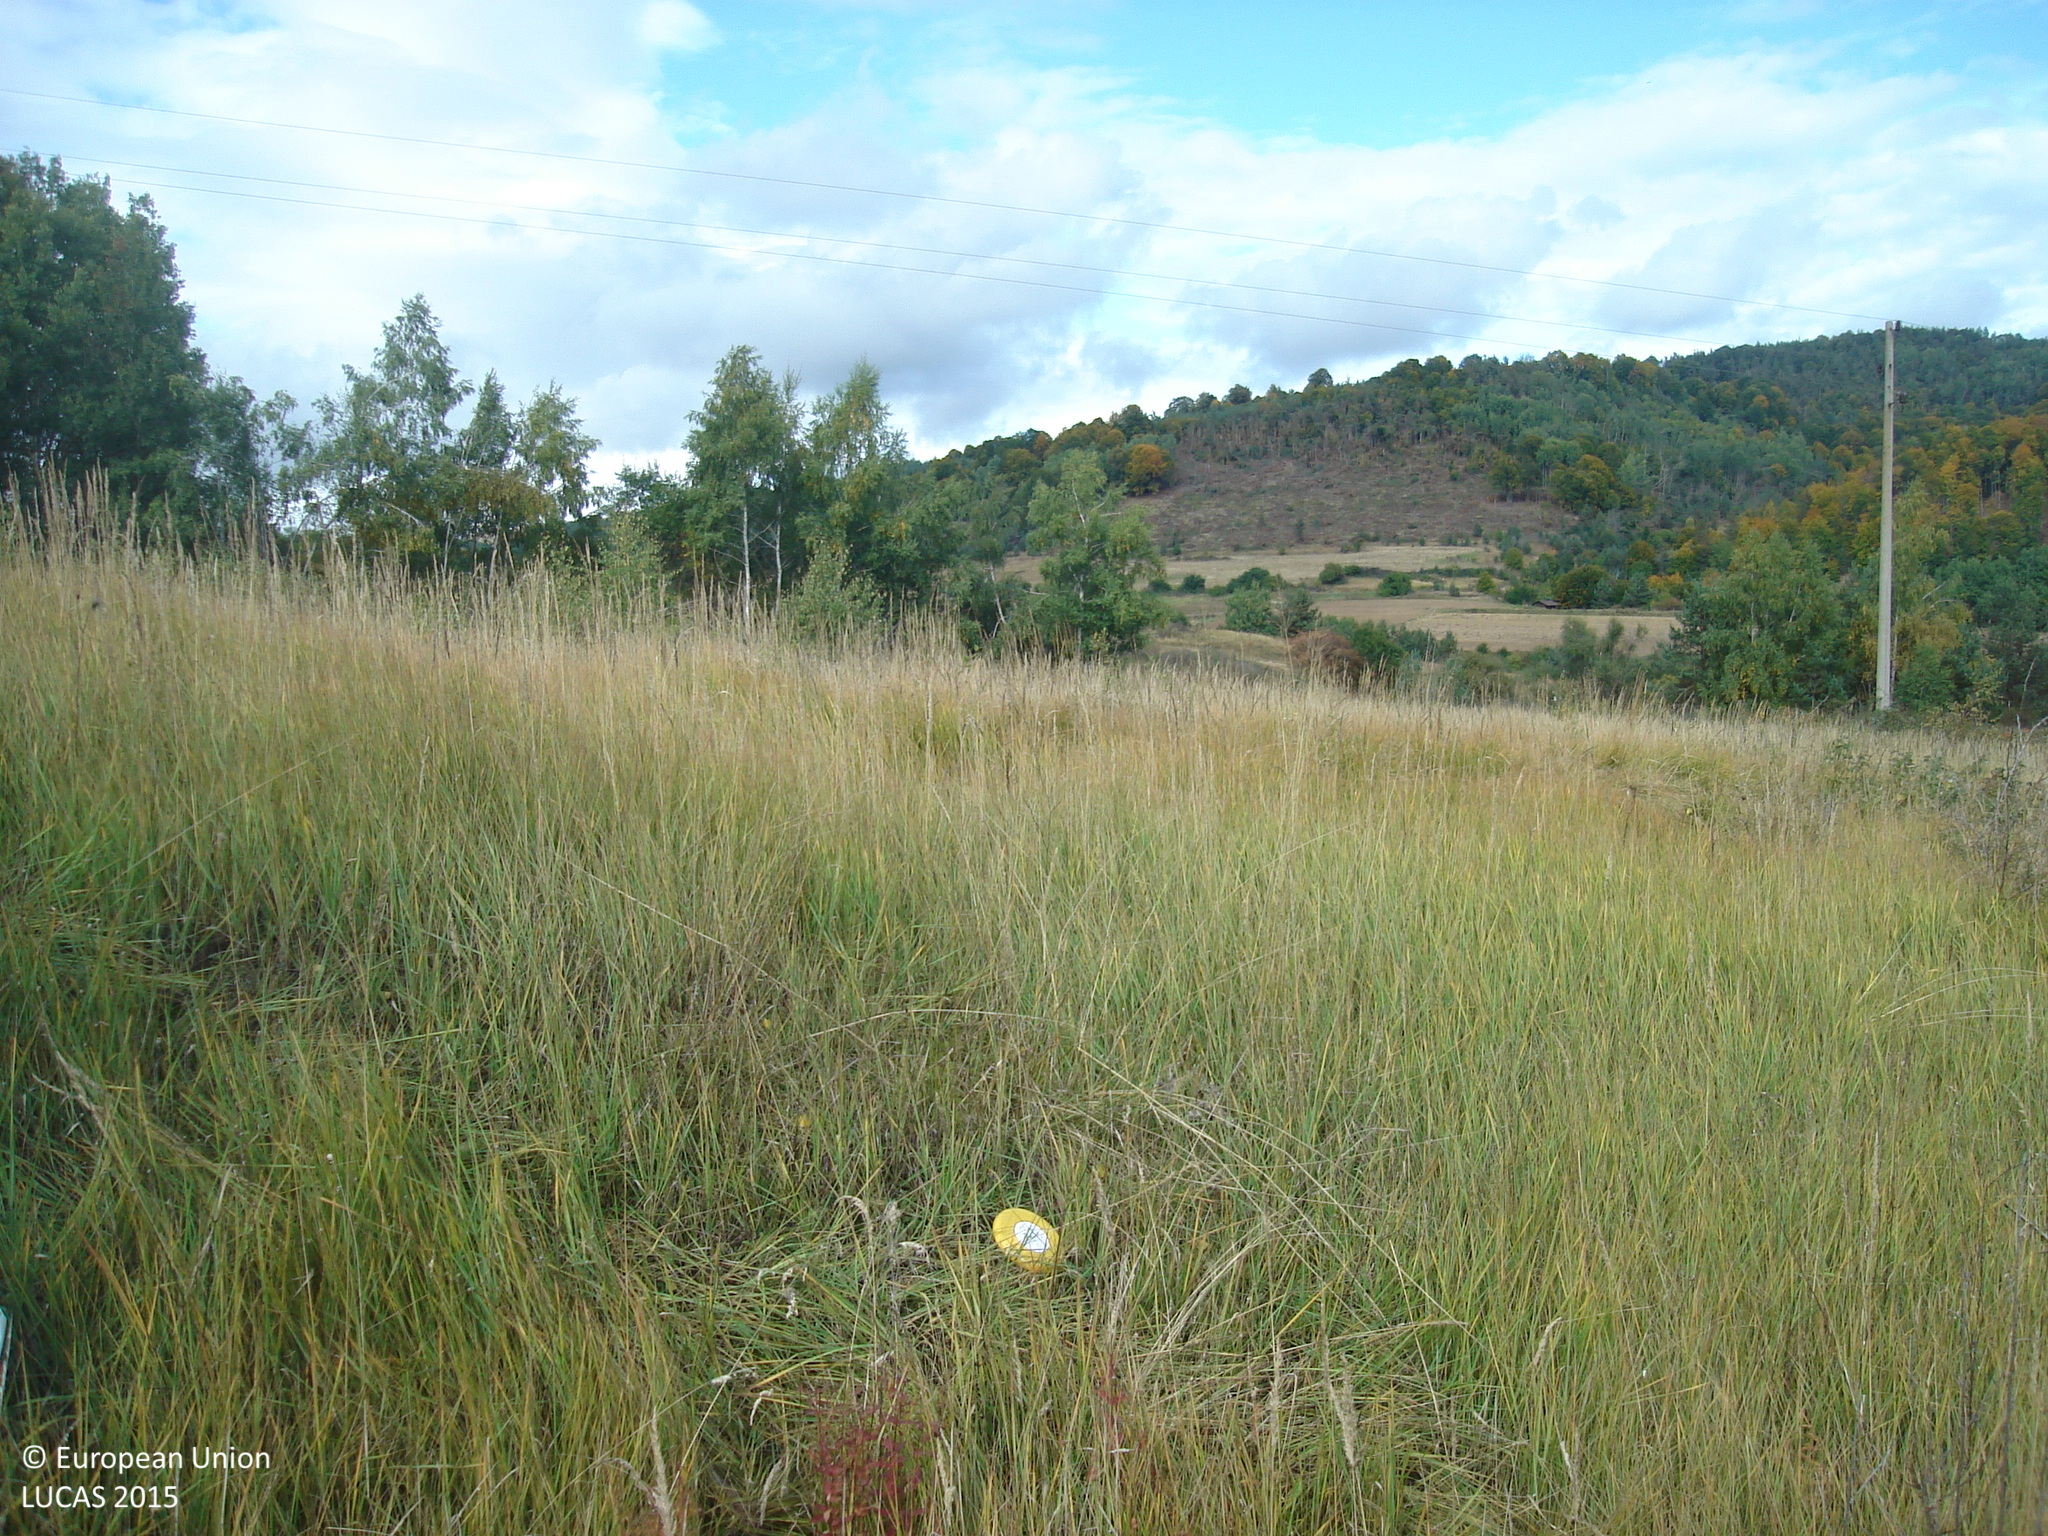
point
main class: Grassland
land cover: Grassland with sparse tree/shrub cover
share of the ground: > 75 %
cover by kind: herbaceous plants 95 %, broadleaved forest trees 5 %
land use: Agriculture (excluding fallow land and kitchen gardens)
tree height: > 5 m
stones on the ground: < 10 %
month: October
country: BG
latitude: 42.5905
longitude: 24.3932
